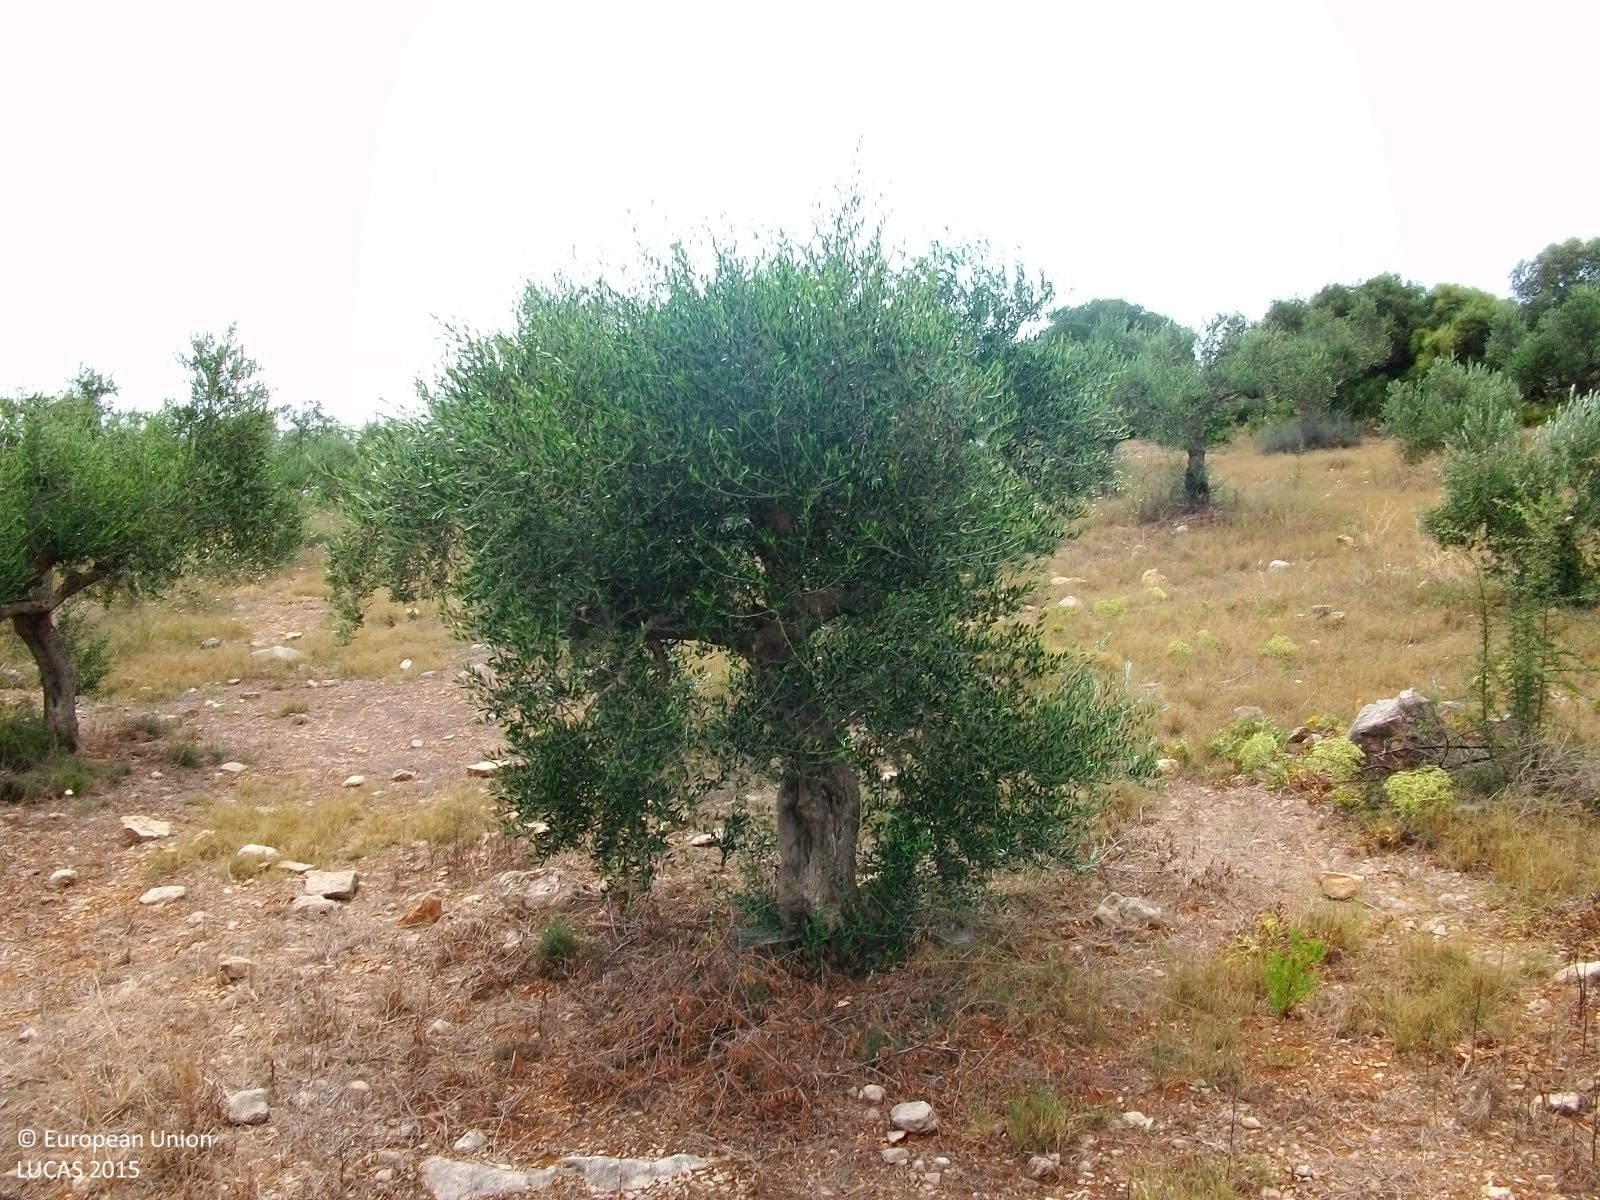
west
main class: Cropland
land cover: Olive groves
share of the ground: > 75 %
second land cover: Spontaneously vegetated surfaces
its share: > 75 %
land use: Agriculture (excluding fallow land and kitchen gardens)
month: July
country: GR
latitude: 36.8393
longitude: 21.8469
